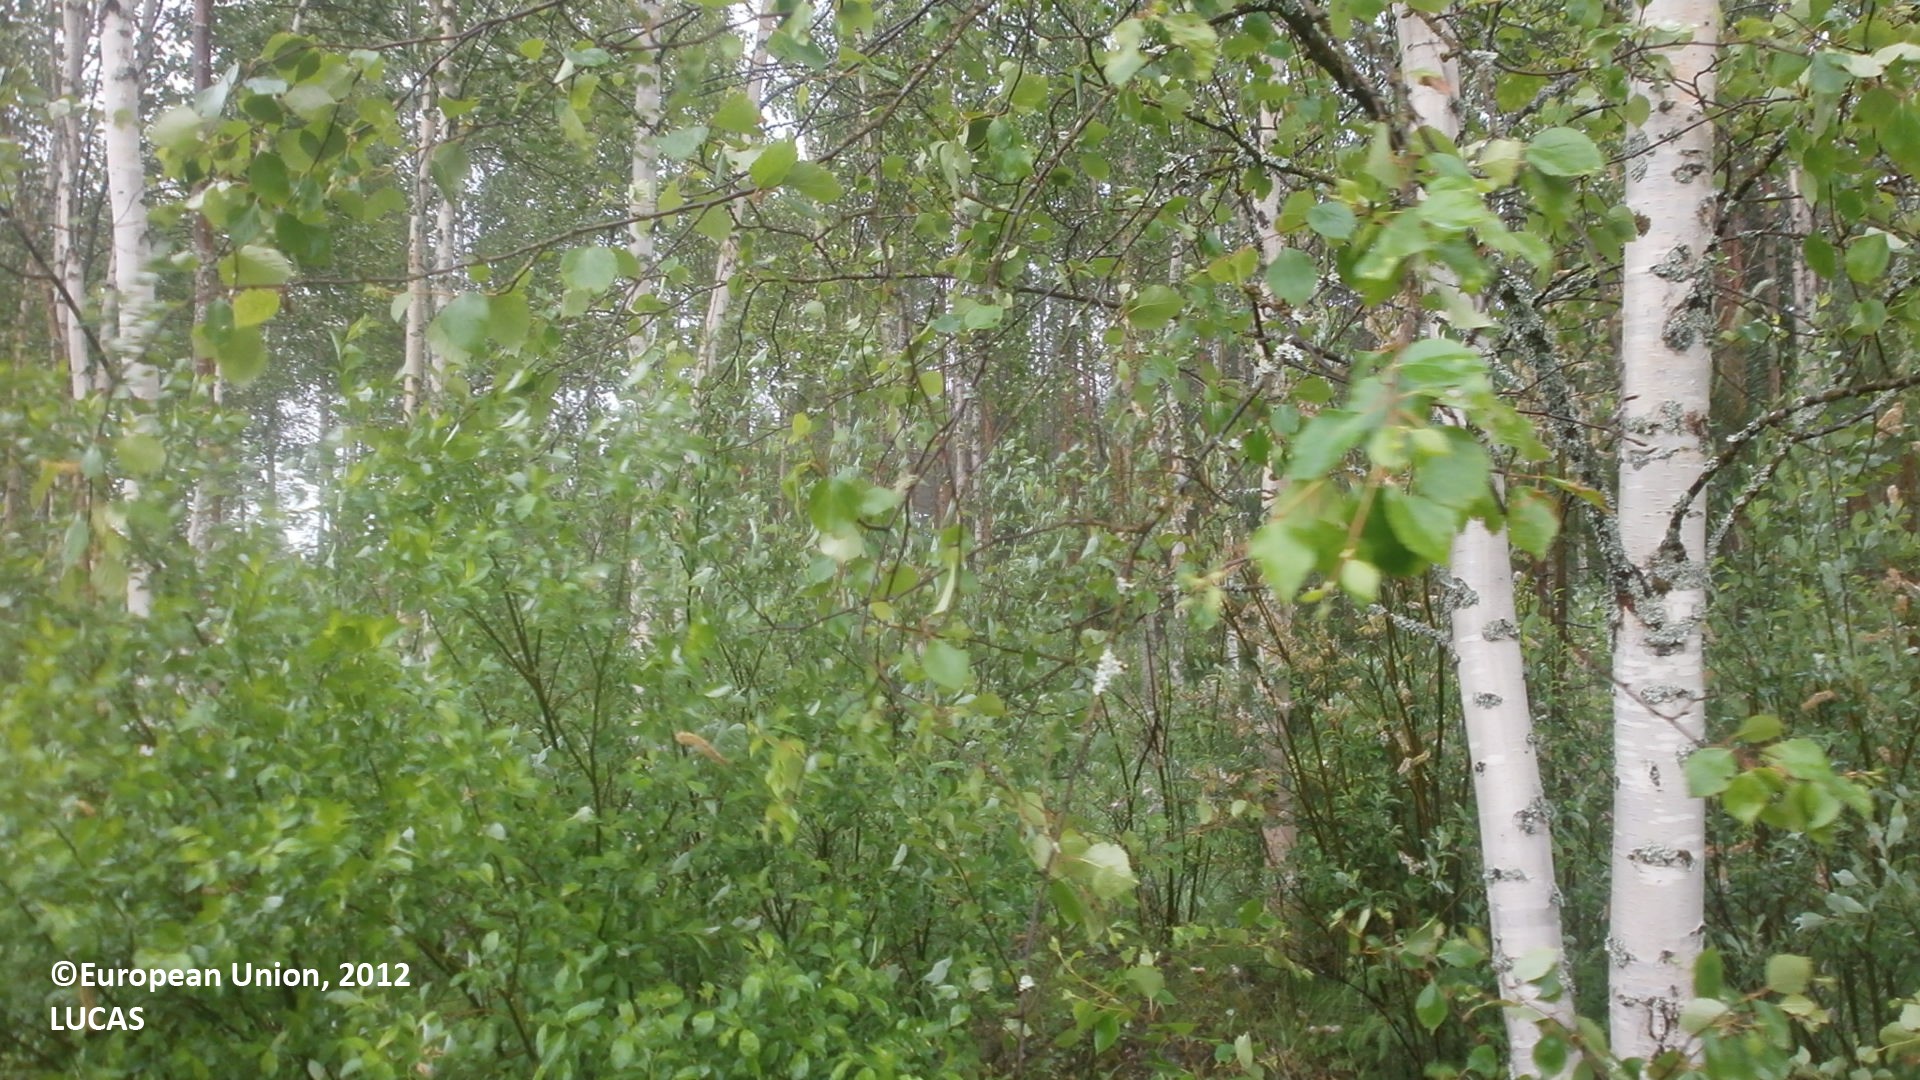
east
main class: Cropland
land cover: Oats
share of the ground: 25 - 50 %
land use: Agriculture (excluding fallow land and kitchen gardens)
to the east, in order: Oats; Shruby margins; Ditches and canals; Shruby margins; Oats; Shruby margins; Ditches and canals; Shruby margins; Oats; Shruby margins; Ditches and canals; Broadleaved woodland; Artificial constructions in urban areas; Spruce dominated coniferous woodland; Ditches and canals; Shrubland with sparse tree cover; Broadleaved woodland; Inland running water; Broadleaved woodland; Spontaneously vegetated surfaces; Ditches and canals; Spontaneously vegetated surfaces; Ditches and canals; Spontaneously vegetated surfaces
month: June
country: FI
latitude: 64.6495
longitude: 25.0881
